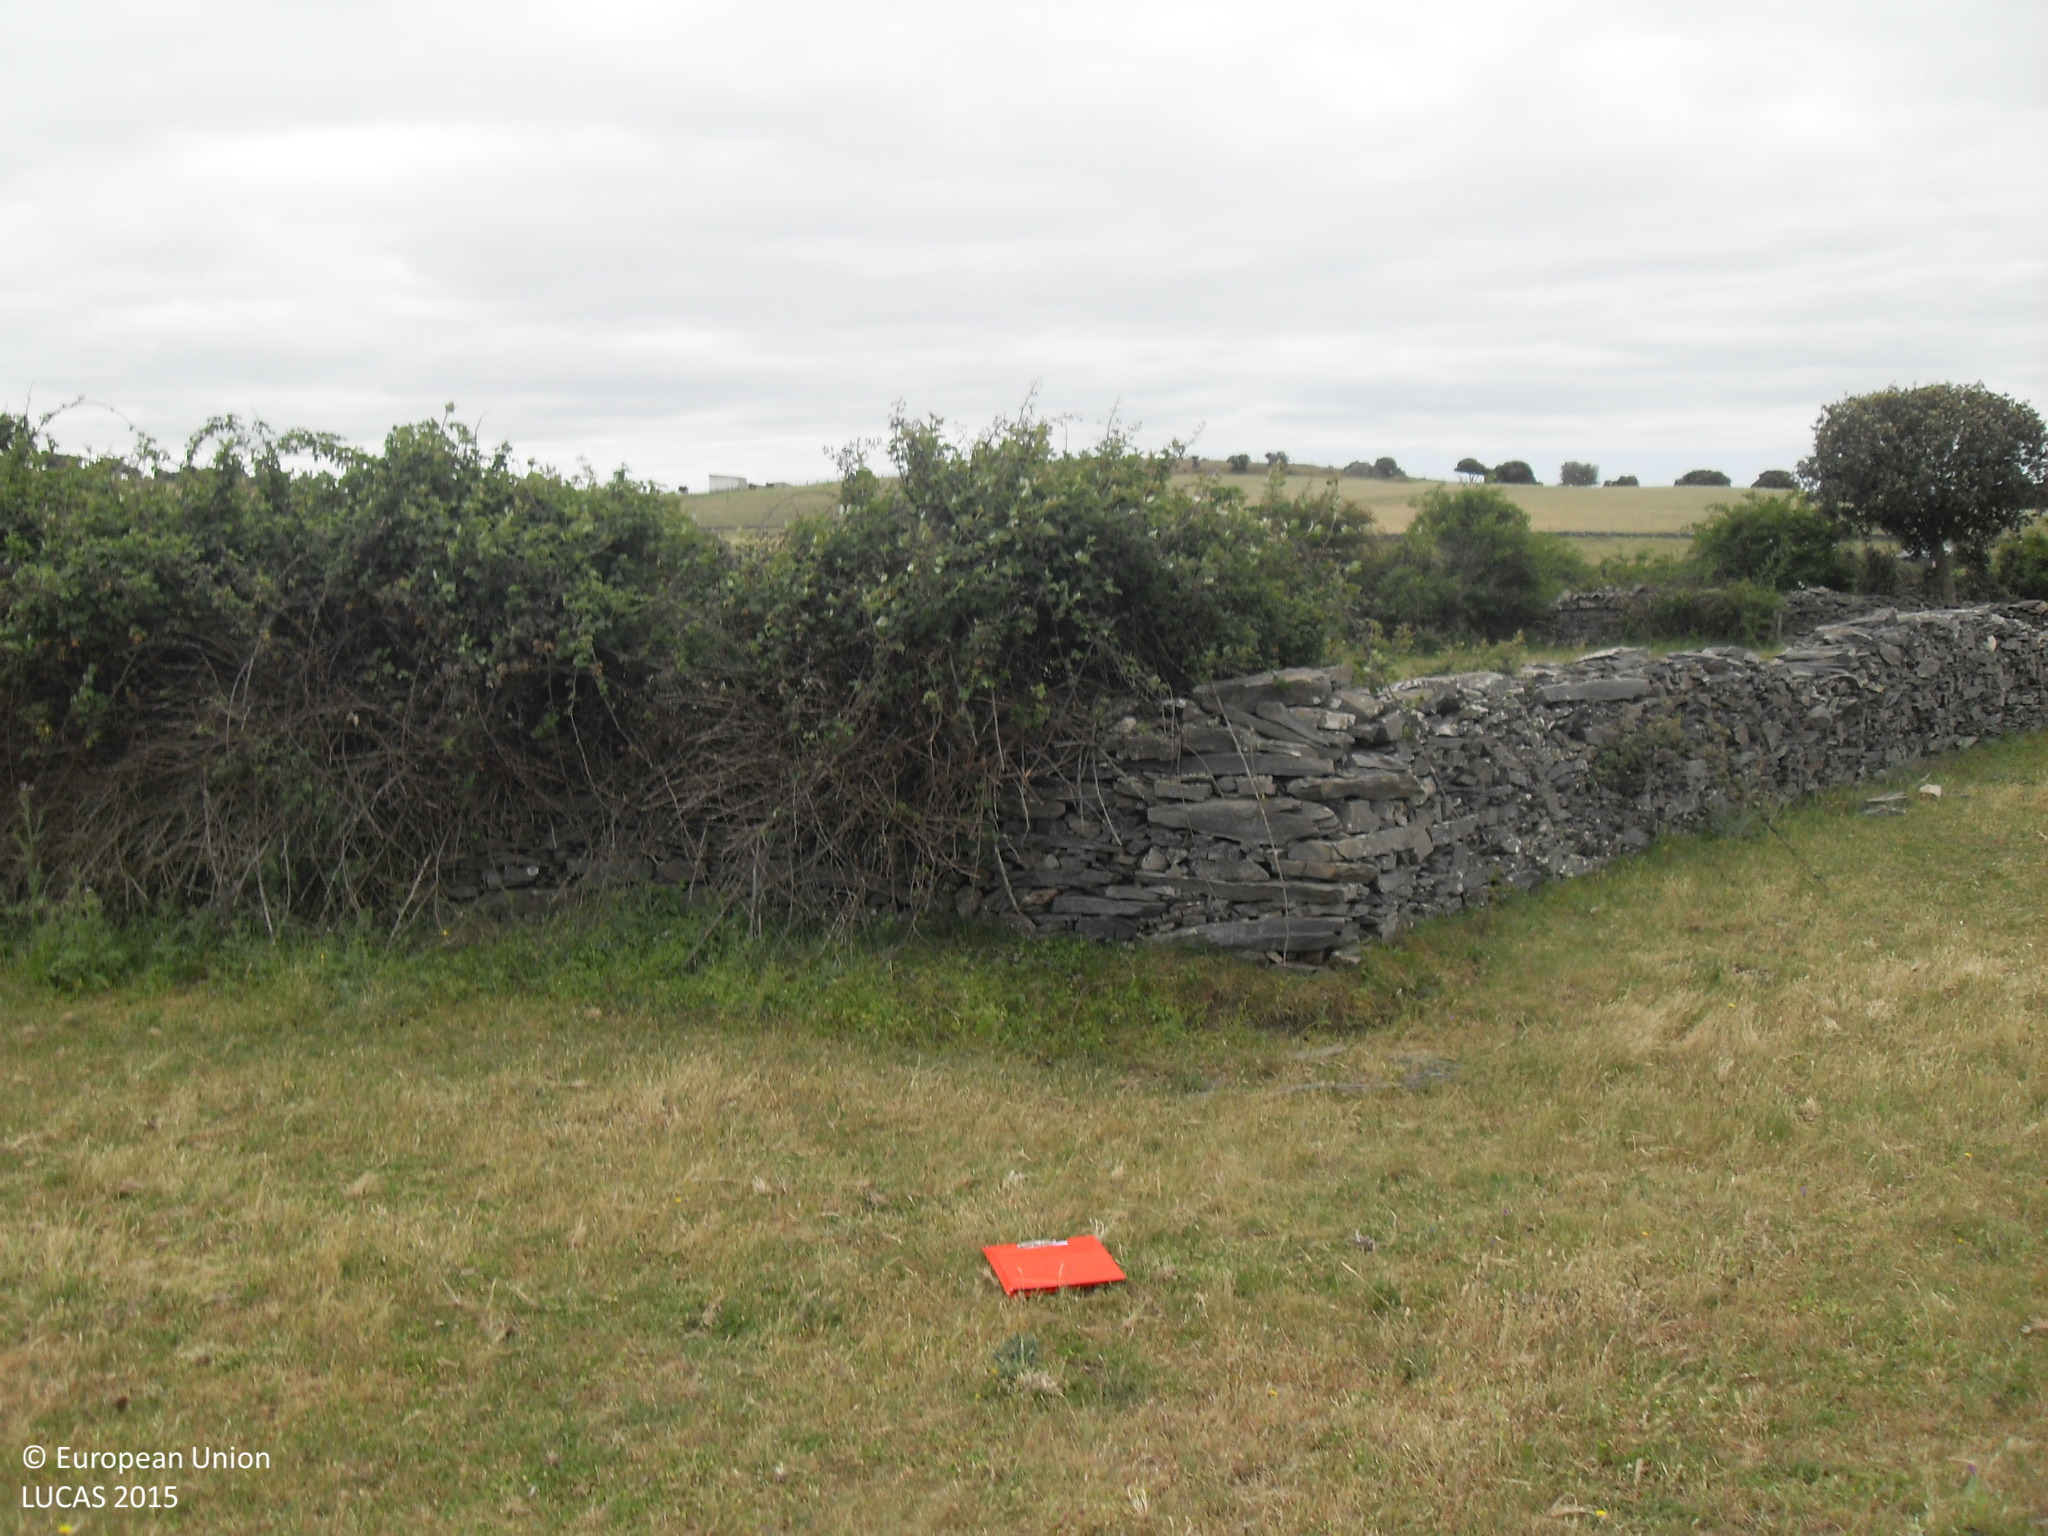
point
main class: Grassland
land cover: Grassland without tree/shrub cover
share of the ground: > 75 %
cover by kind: herbaceous plants 100 %
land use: Agriculture (excluding fallow land and kitchen gardens)
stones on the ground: 10 - 25 %
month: May
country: ES
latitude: 40.6397
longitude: -5.6448
